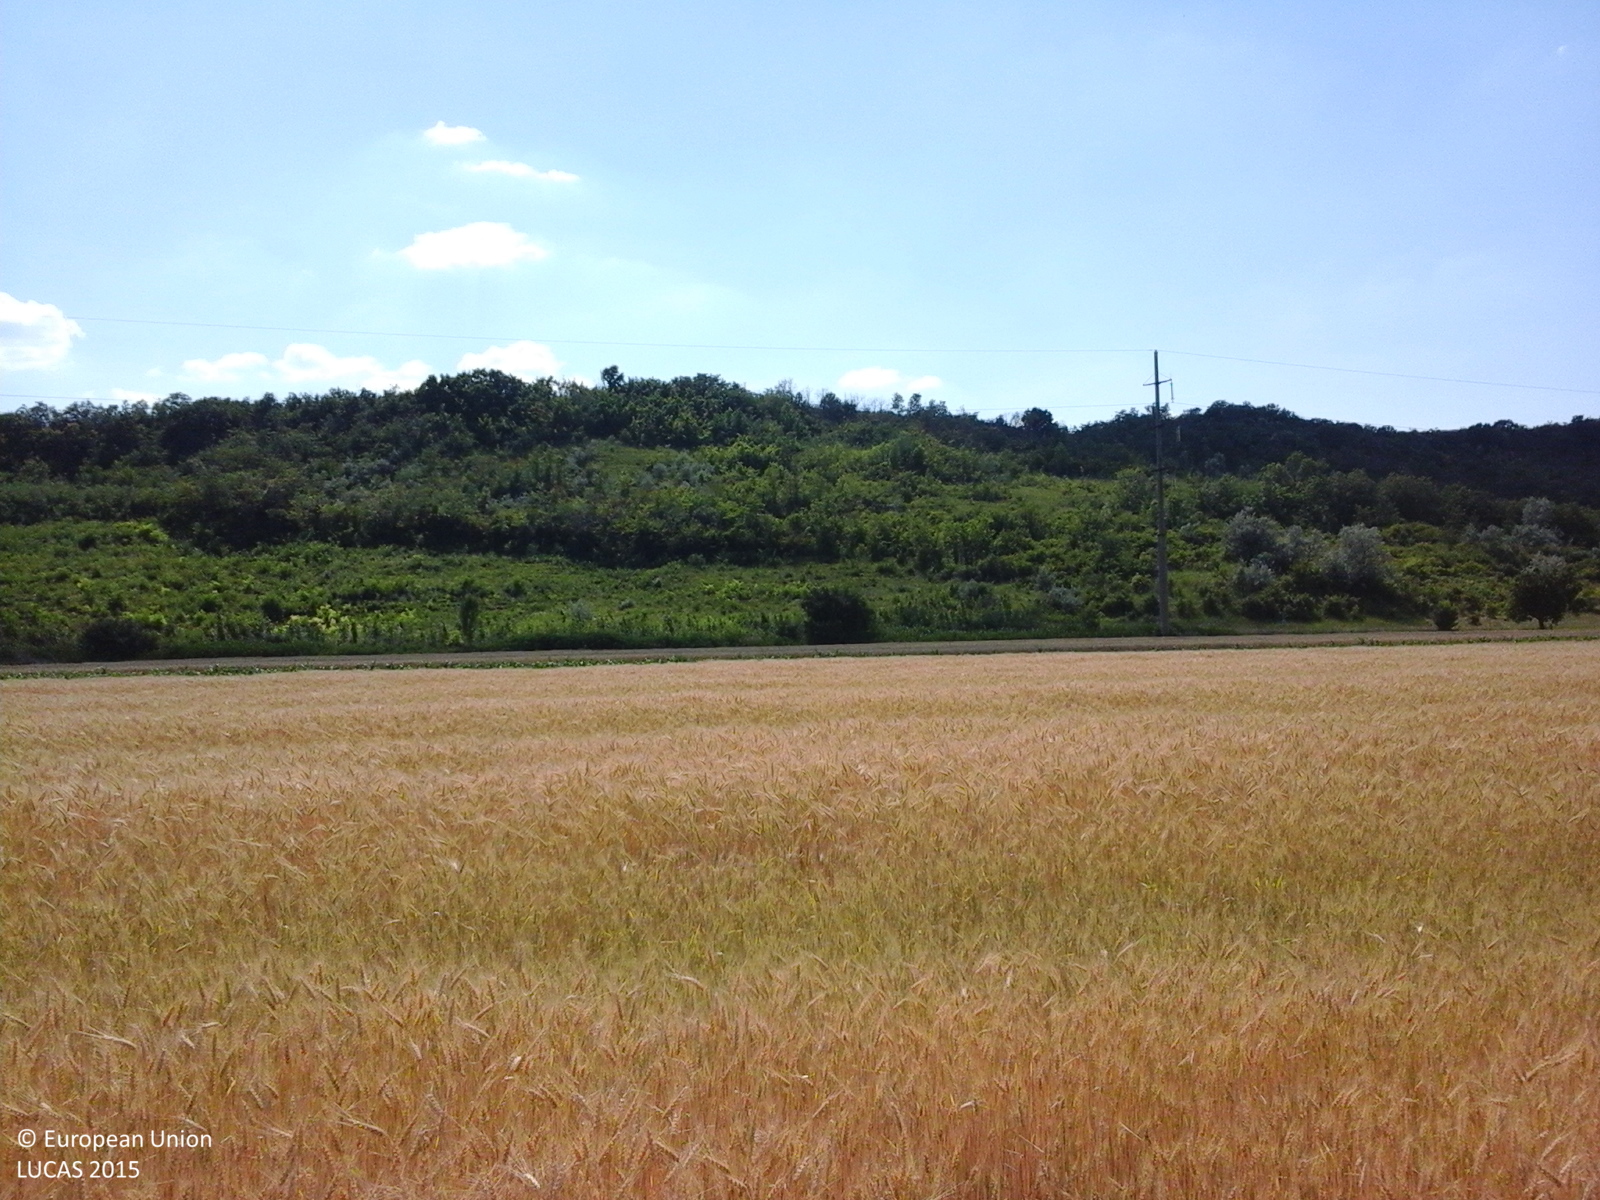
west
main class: Cropland
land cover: Durum wheat
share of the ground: > 75 %
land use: Agriculture (excluding fallow land and kitchen gardens)
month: June
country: RO
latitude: 47.0488
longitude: 27.8297
